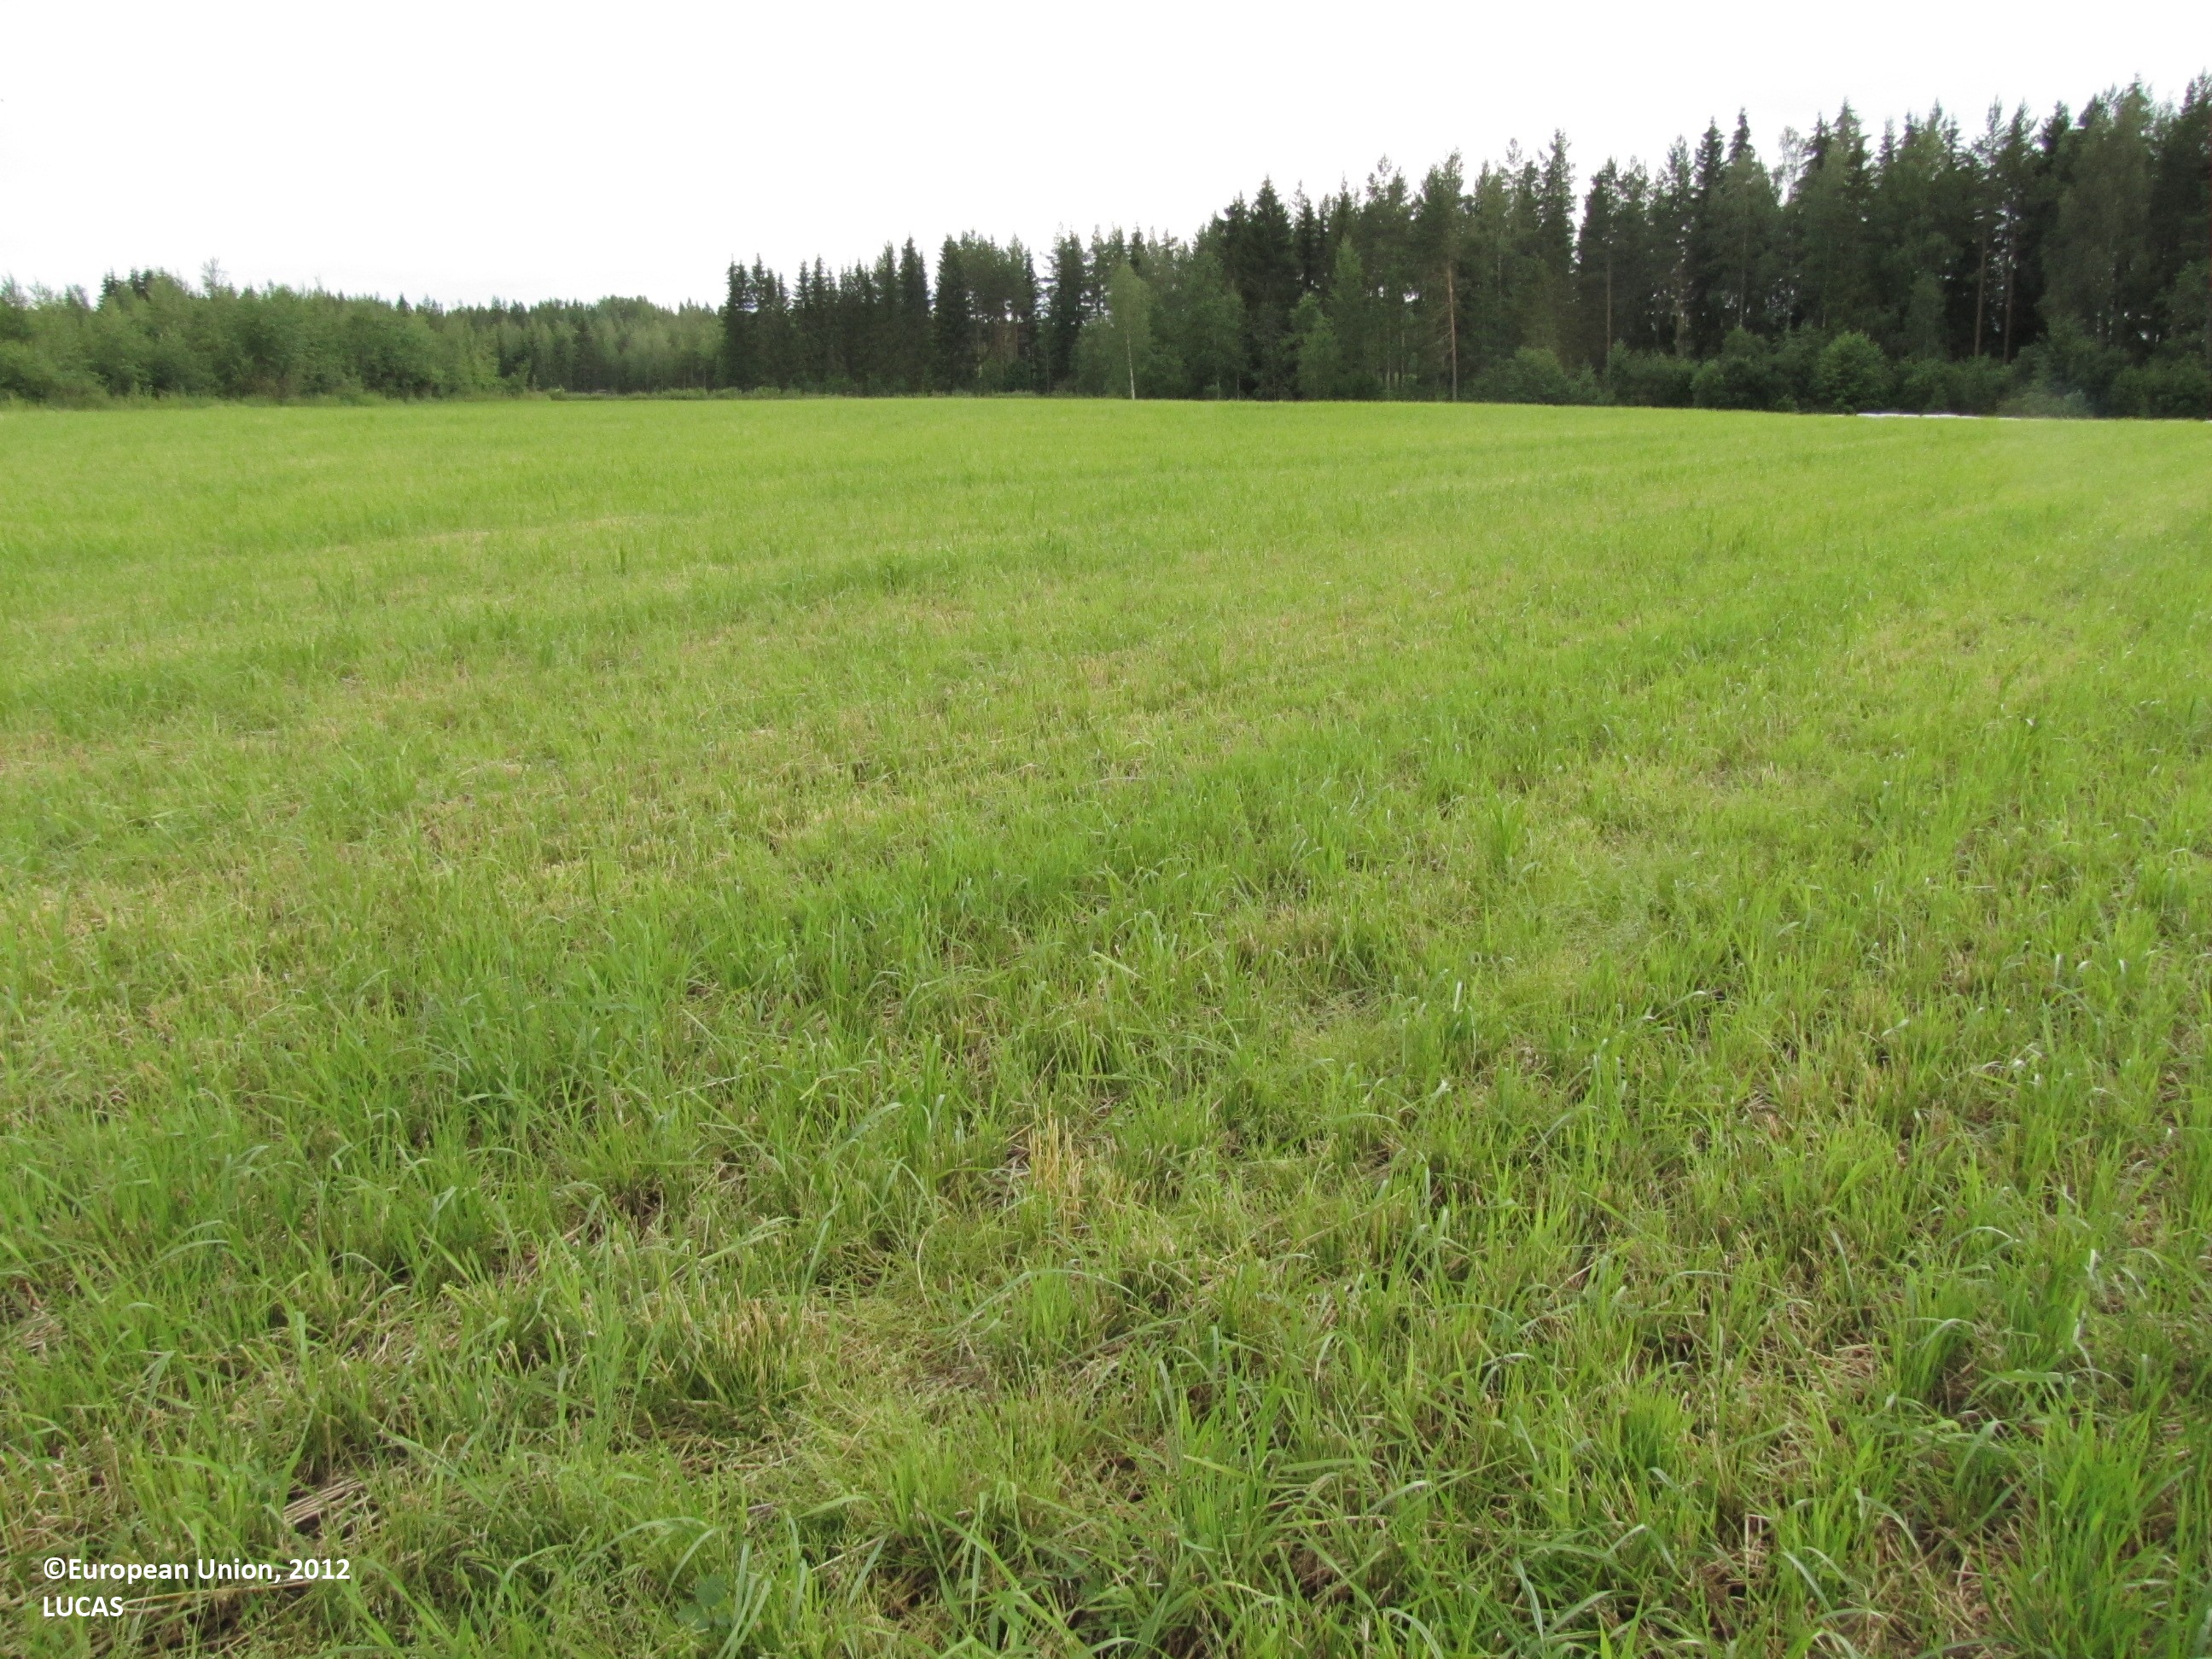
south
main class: Cropland
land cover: Temporary grasslands
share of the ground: > 75 %
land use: Agriculture (excluding fallow land and kitchen gardens)
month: July
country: FI
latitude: 62.4344
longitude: 23.9683
